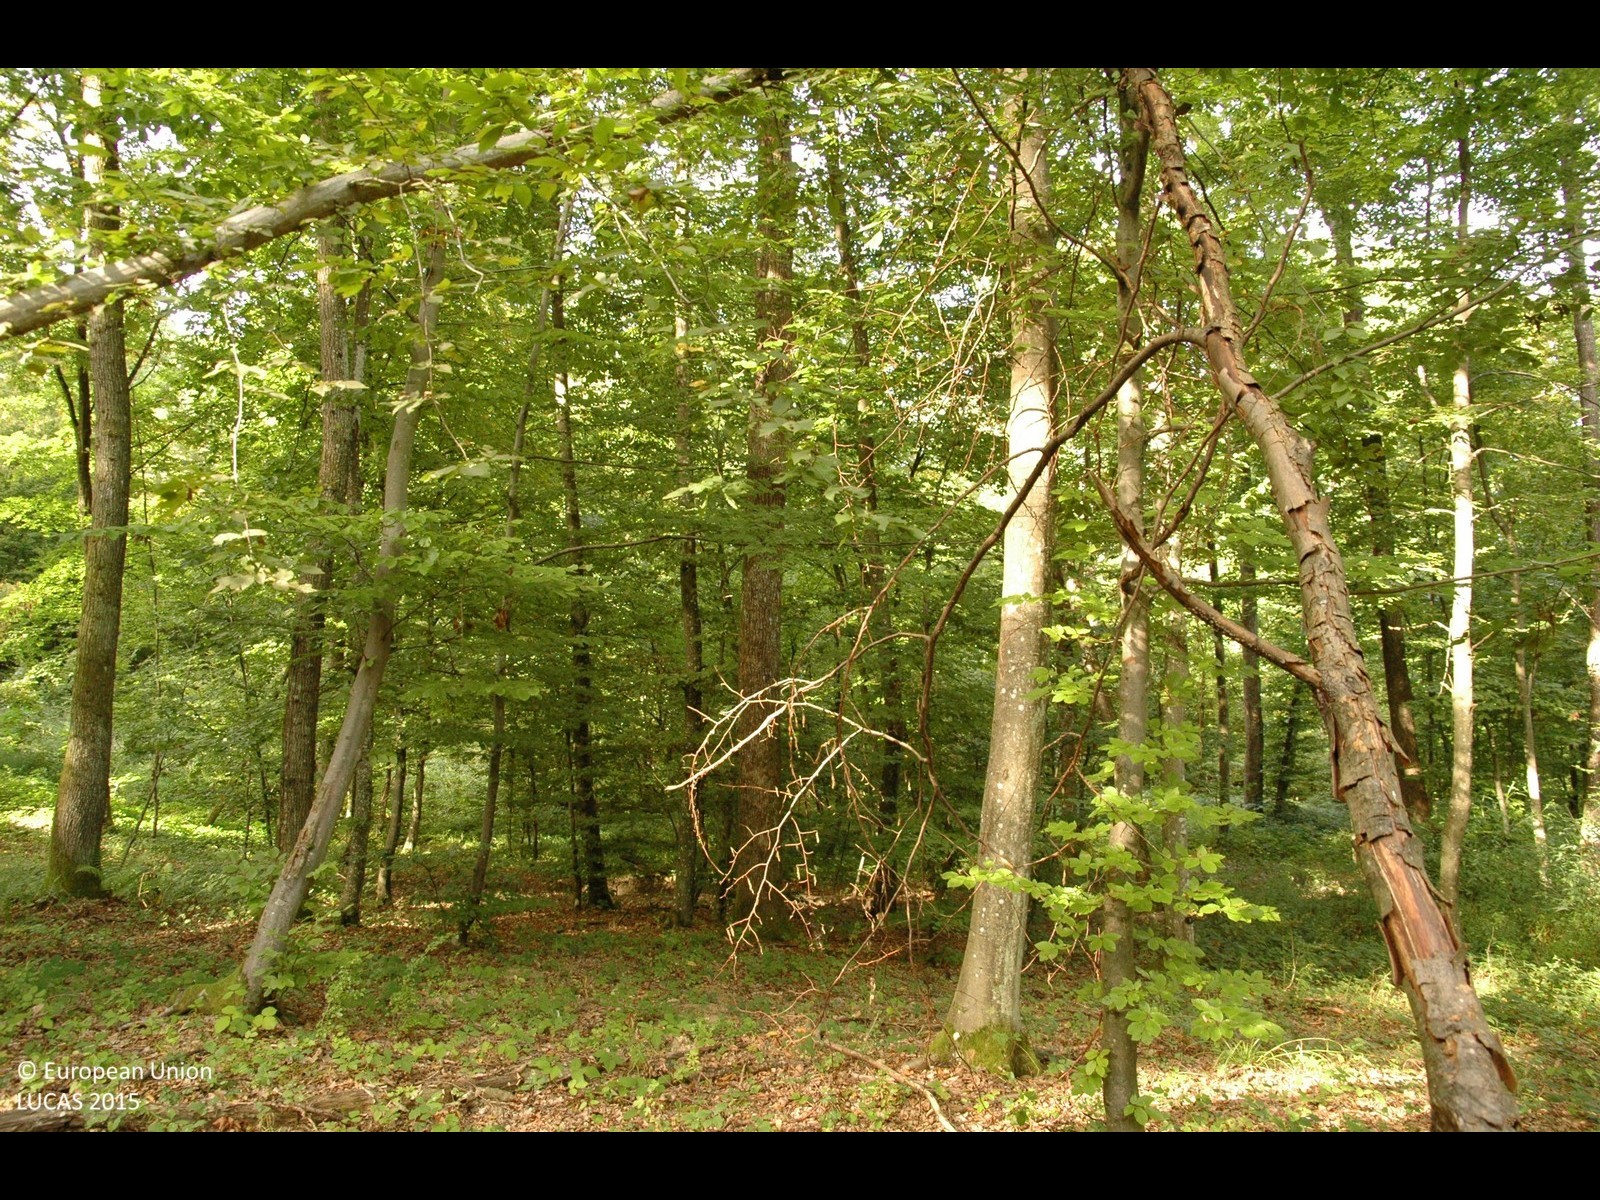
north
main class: Woodland
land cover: Broadleaved woodland
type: mesophytic deciduous forest
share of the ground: > 75 %
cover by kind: broadleaved forest trees 100 %
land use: Forestry
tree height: > 5 m
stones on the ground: < 10 %
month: September
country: HR
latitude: 45.6472
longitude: 15.8867
